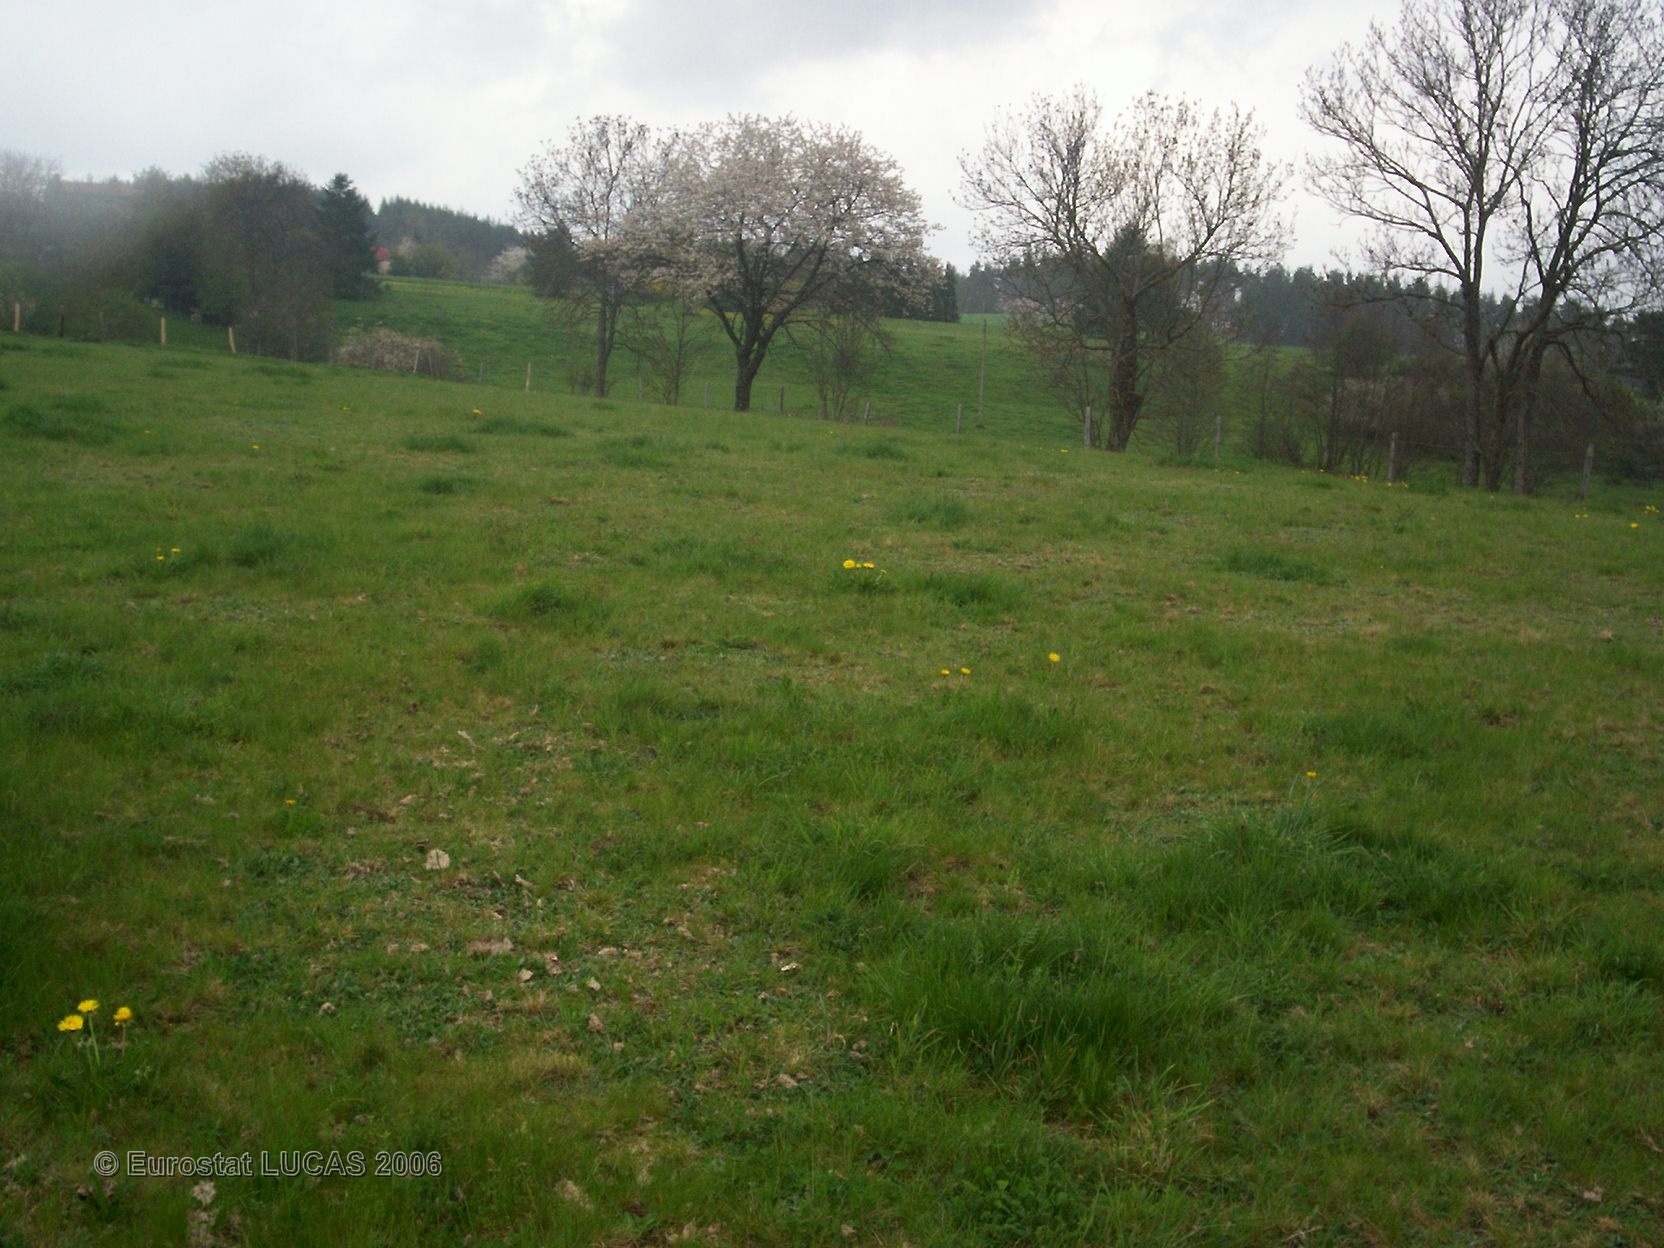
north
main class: Grassland
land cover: Grassland without tree/shrub cover
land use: Agriculture (excluding fallow land and kitchen gardens)
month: April
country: FR
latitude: 45.2536
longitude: 4.1808
